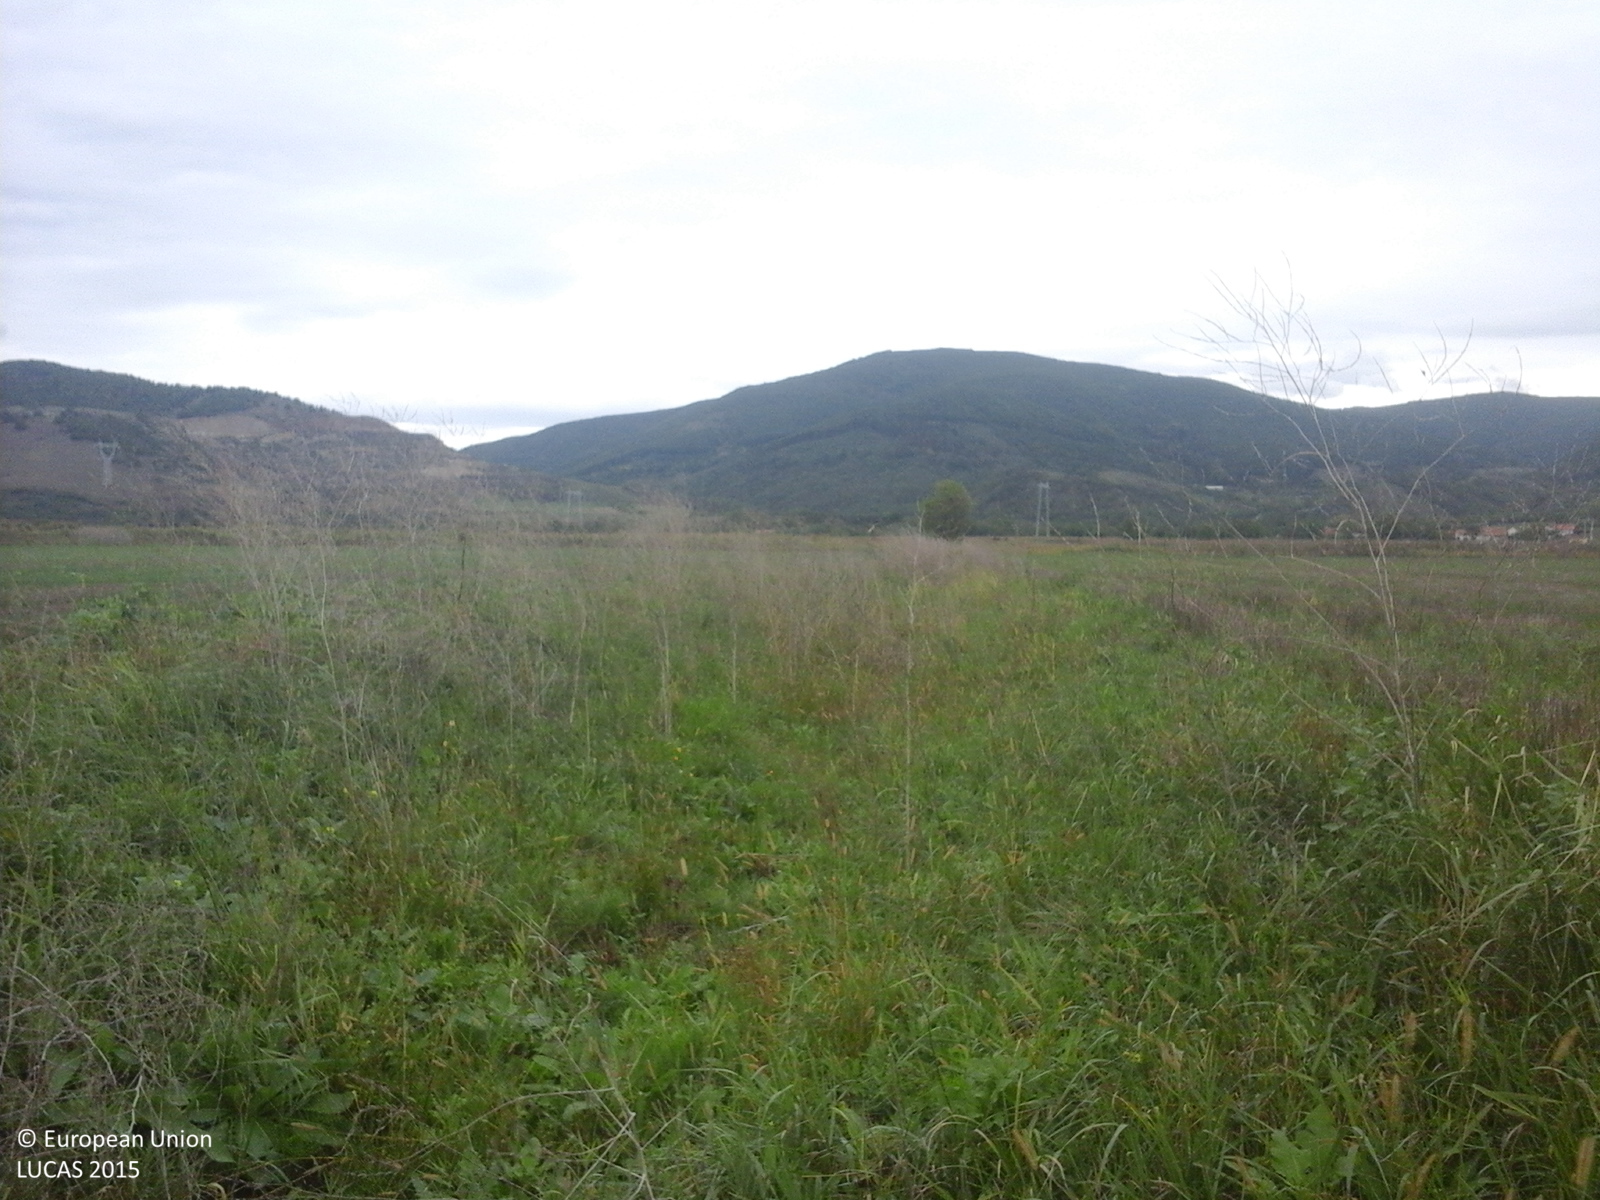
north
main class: Grassland
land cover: Spontaneously vegetated surfaces
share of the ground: > 75 %
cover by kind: herbaceous plants 100 %
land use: Fallow land
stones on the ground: < 10 %
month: September
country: RO
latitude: 45.8815
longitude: 23.0049
